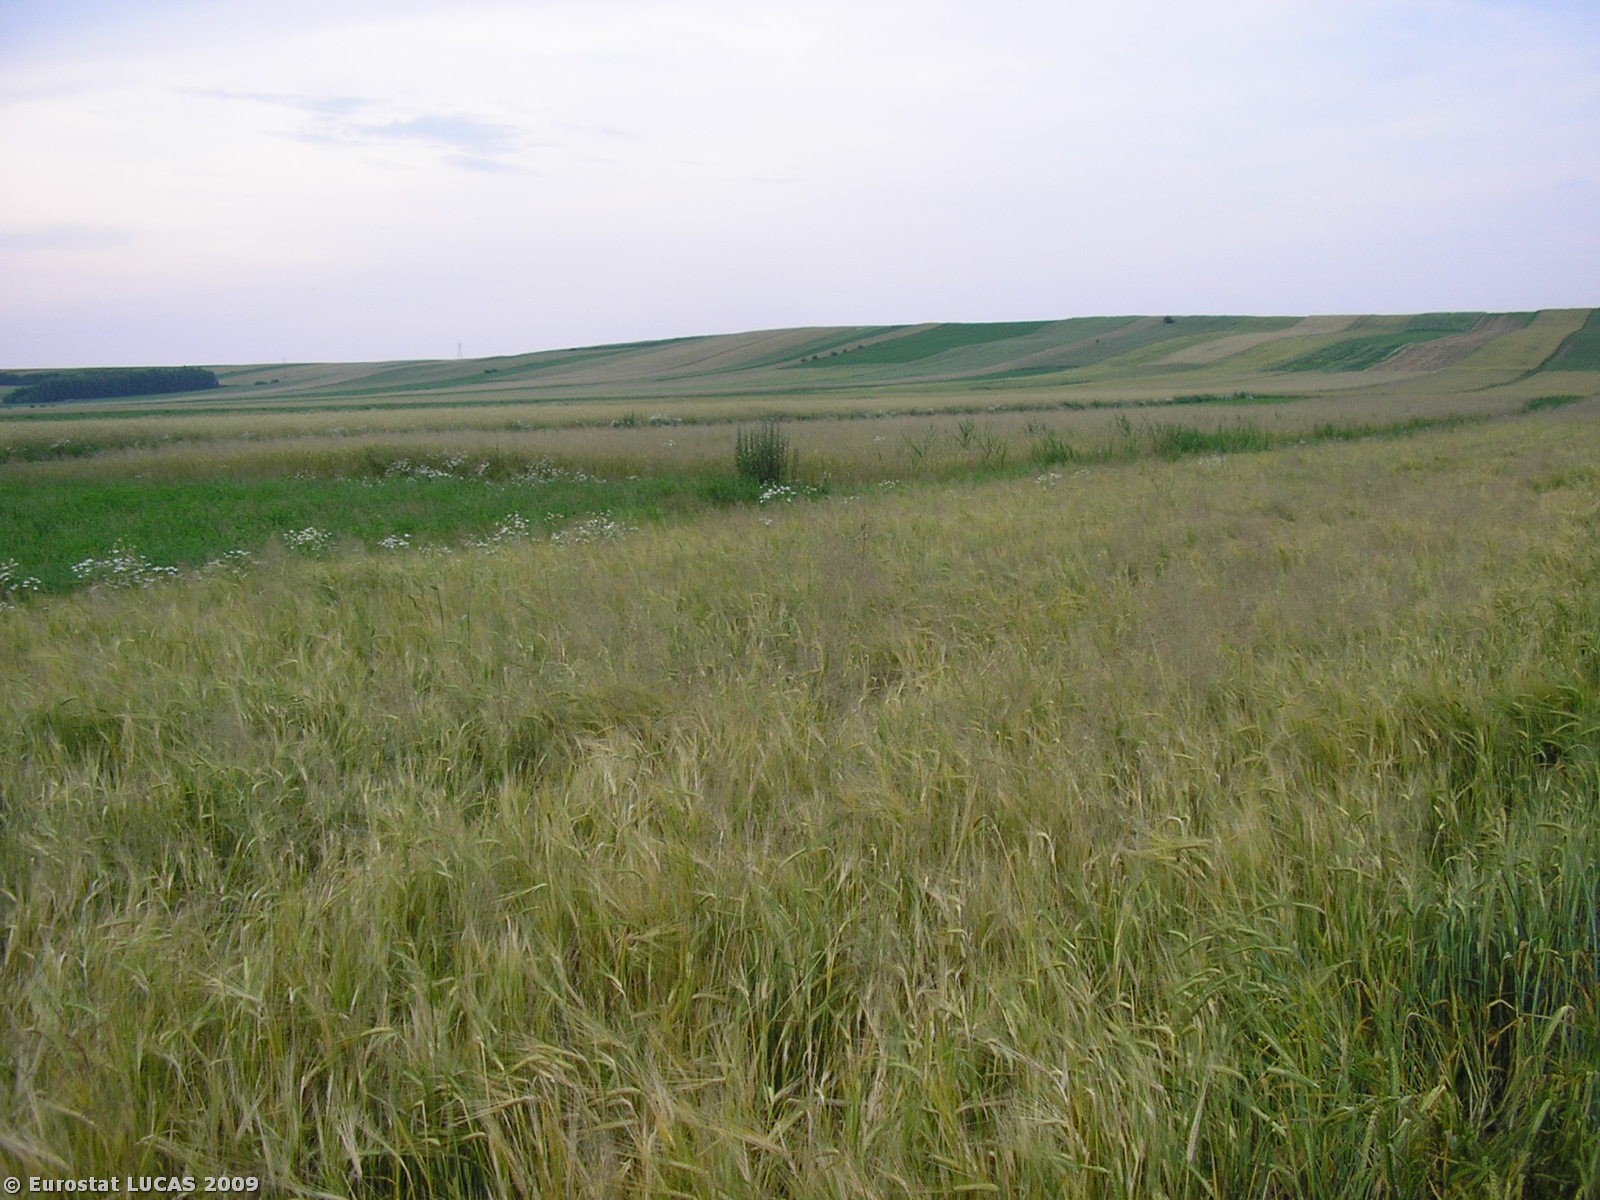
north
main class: Cropland
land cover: Barley
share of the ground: > 75 %
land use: Agriculture (excluding fallow land and kitchen gardens)
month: June
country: PL
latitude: 50.4286
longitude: 20.6396
